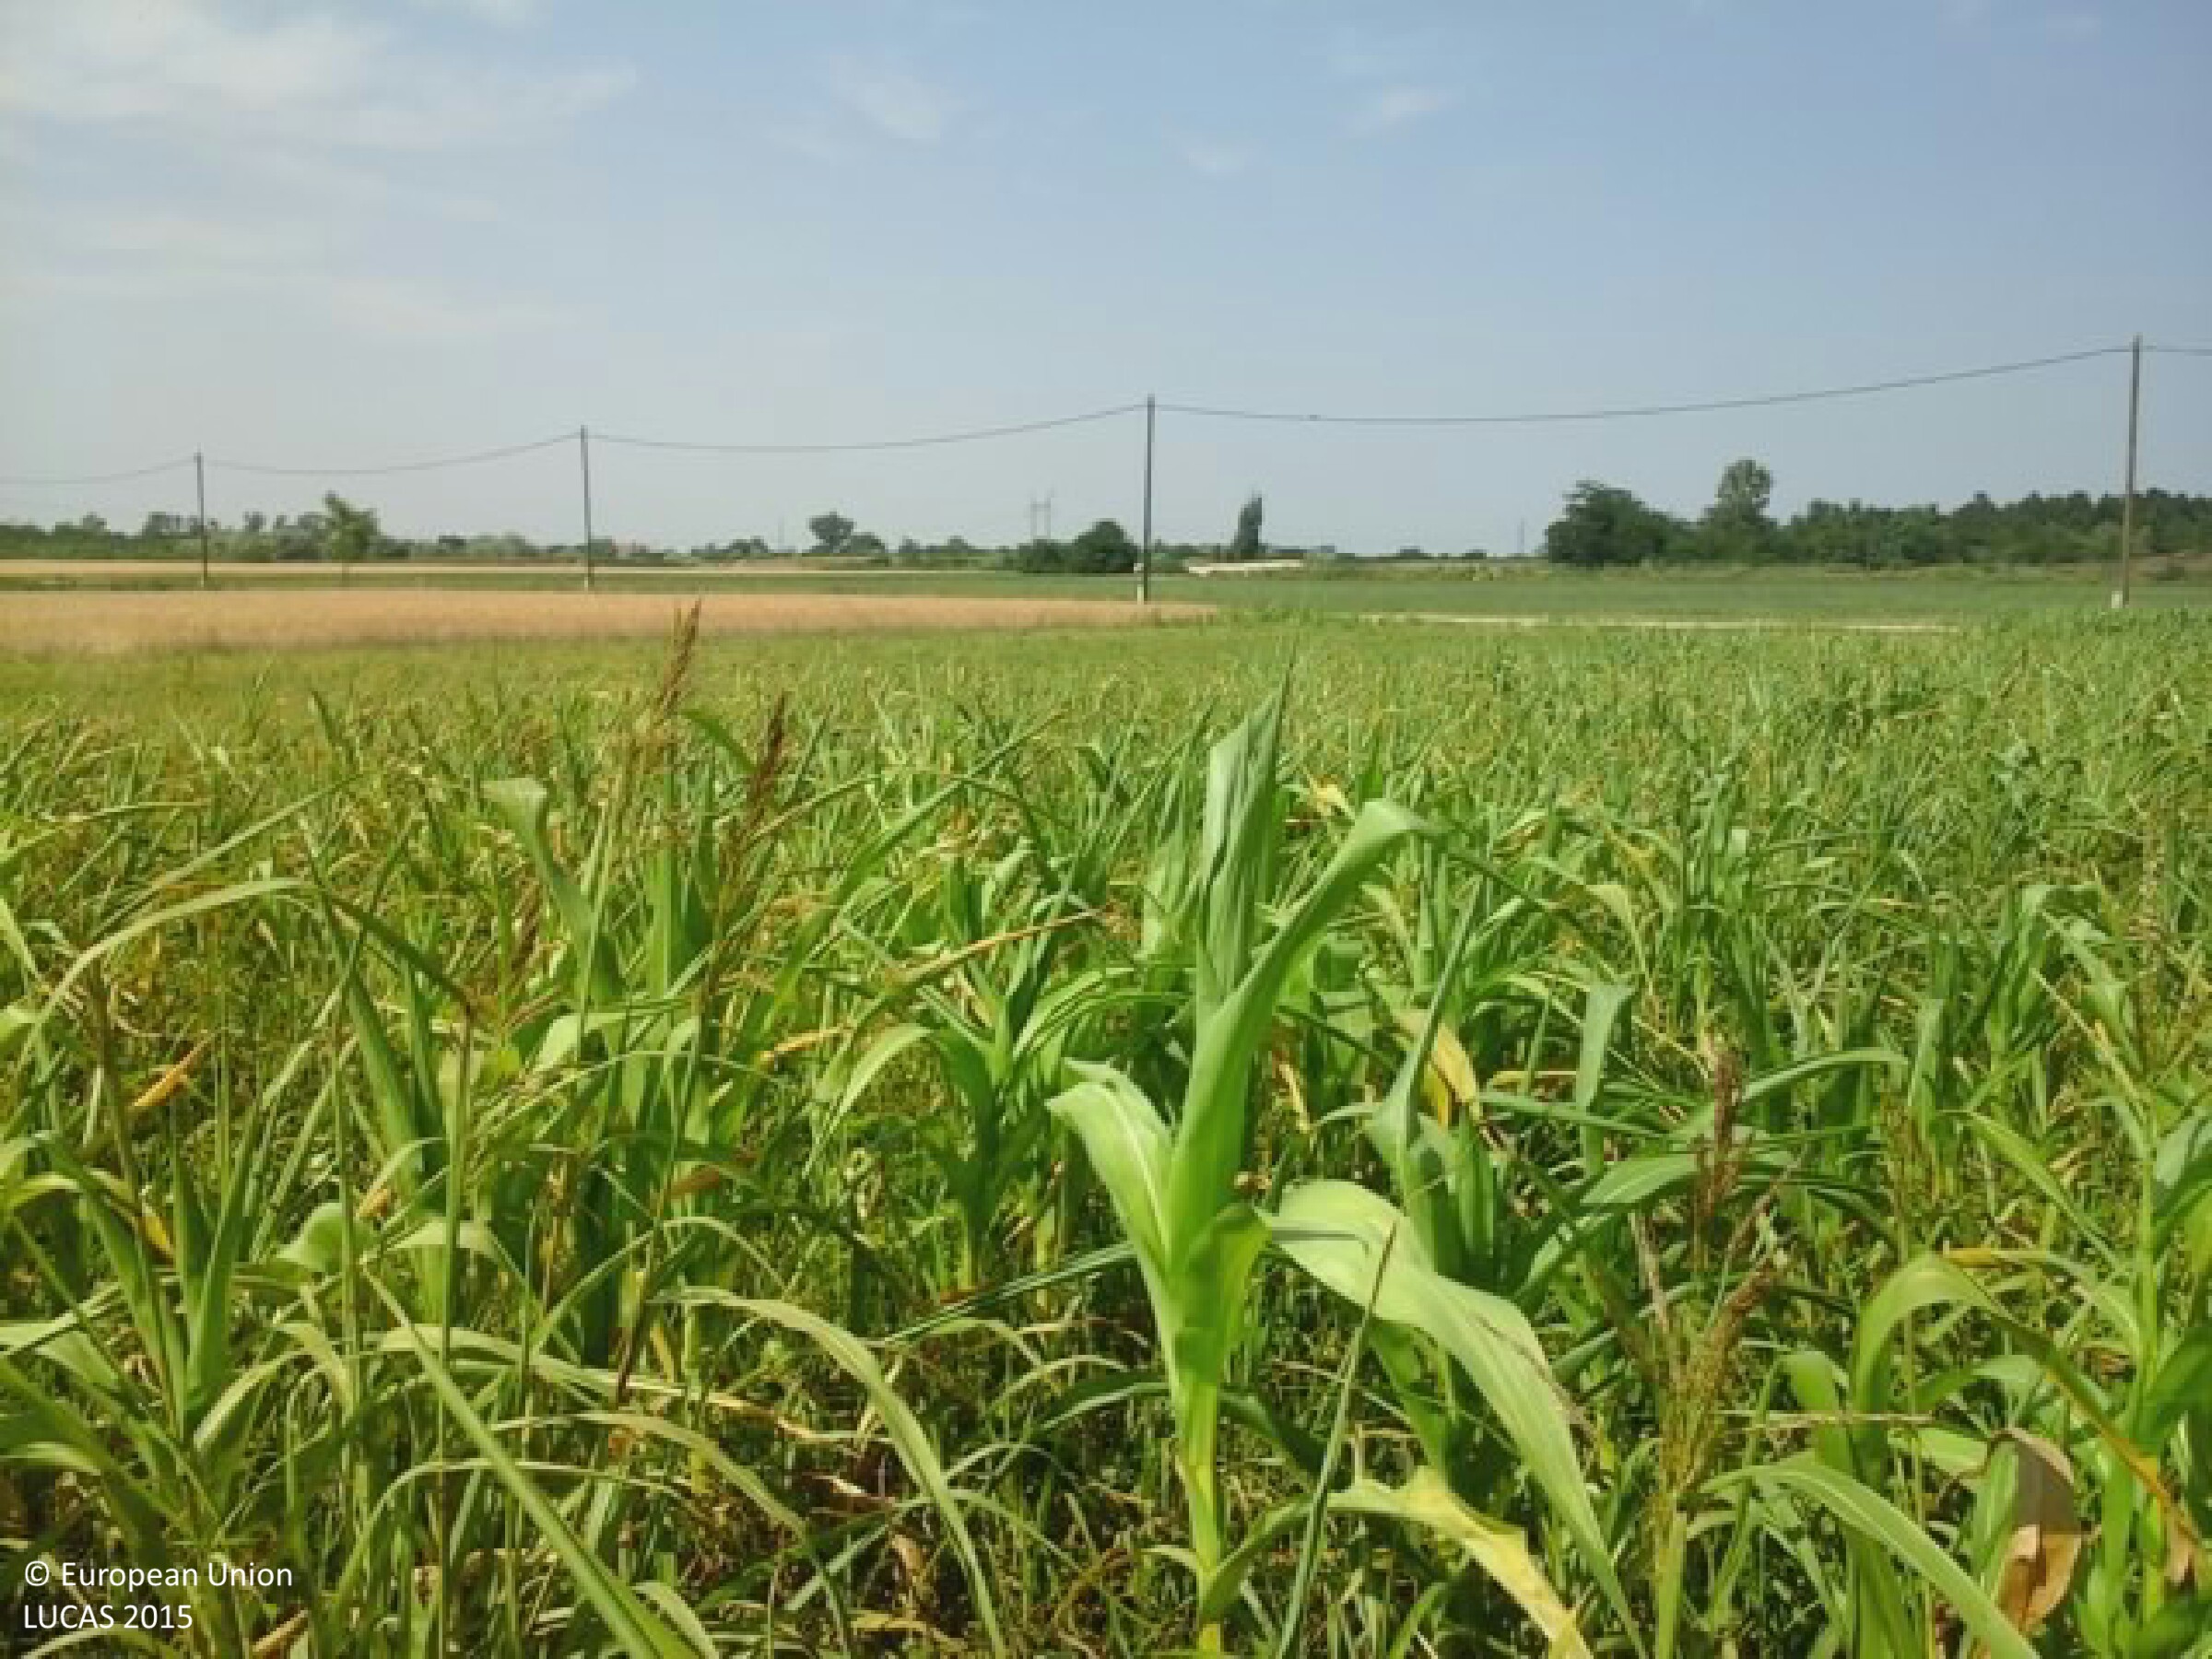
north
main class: Cropland
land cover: Maize
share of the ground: 50 - 75 %
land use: Agriculture (excluding fallow land and kitchen gardens)
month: July
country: HU
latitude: 47.2315
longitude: 19.0912
